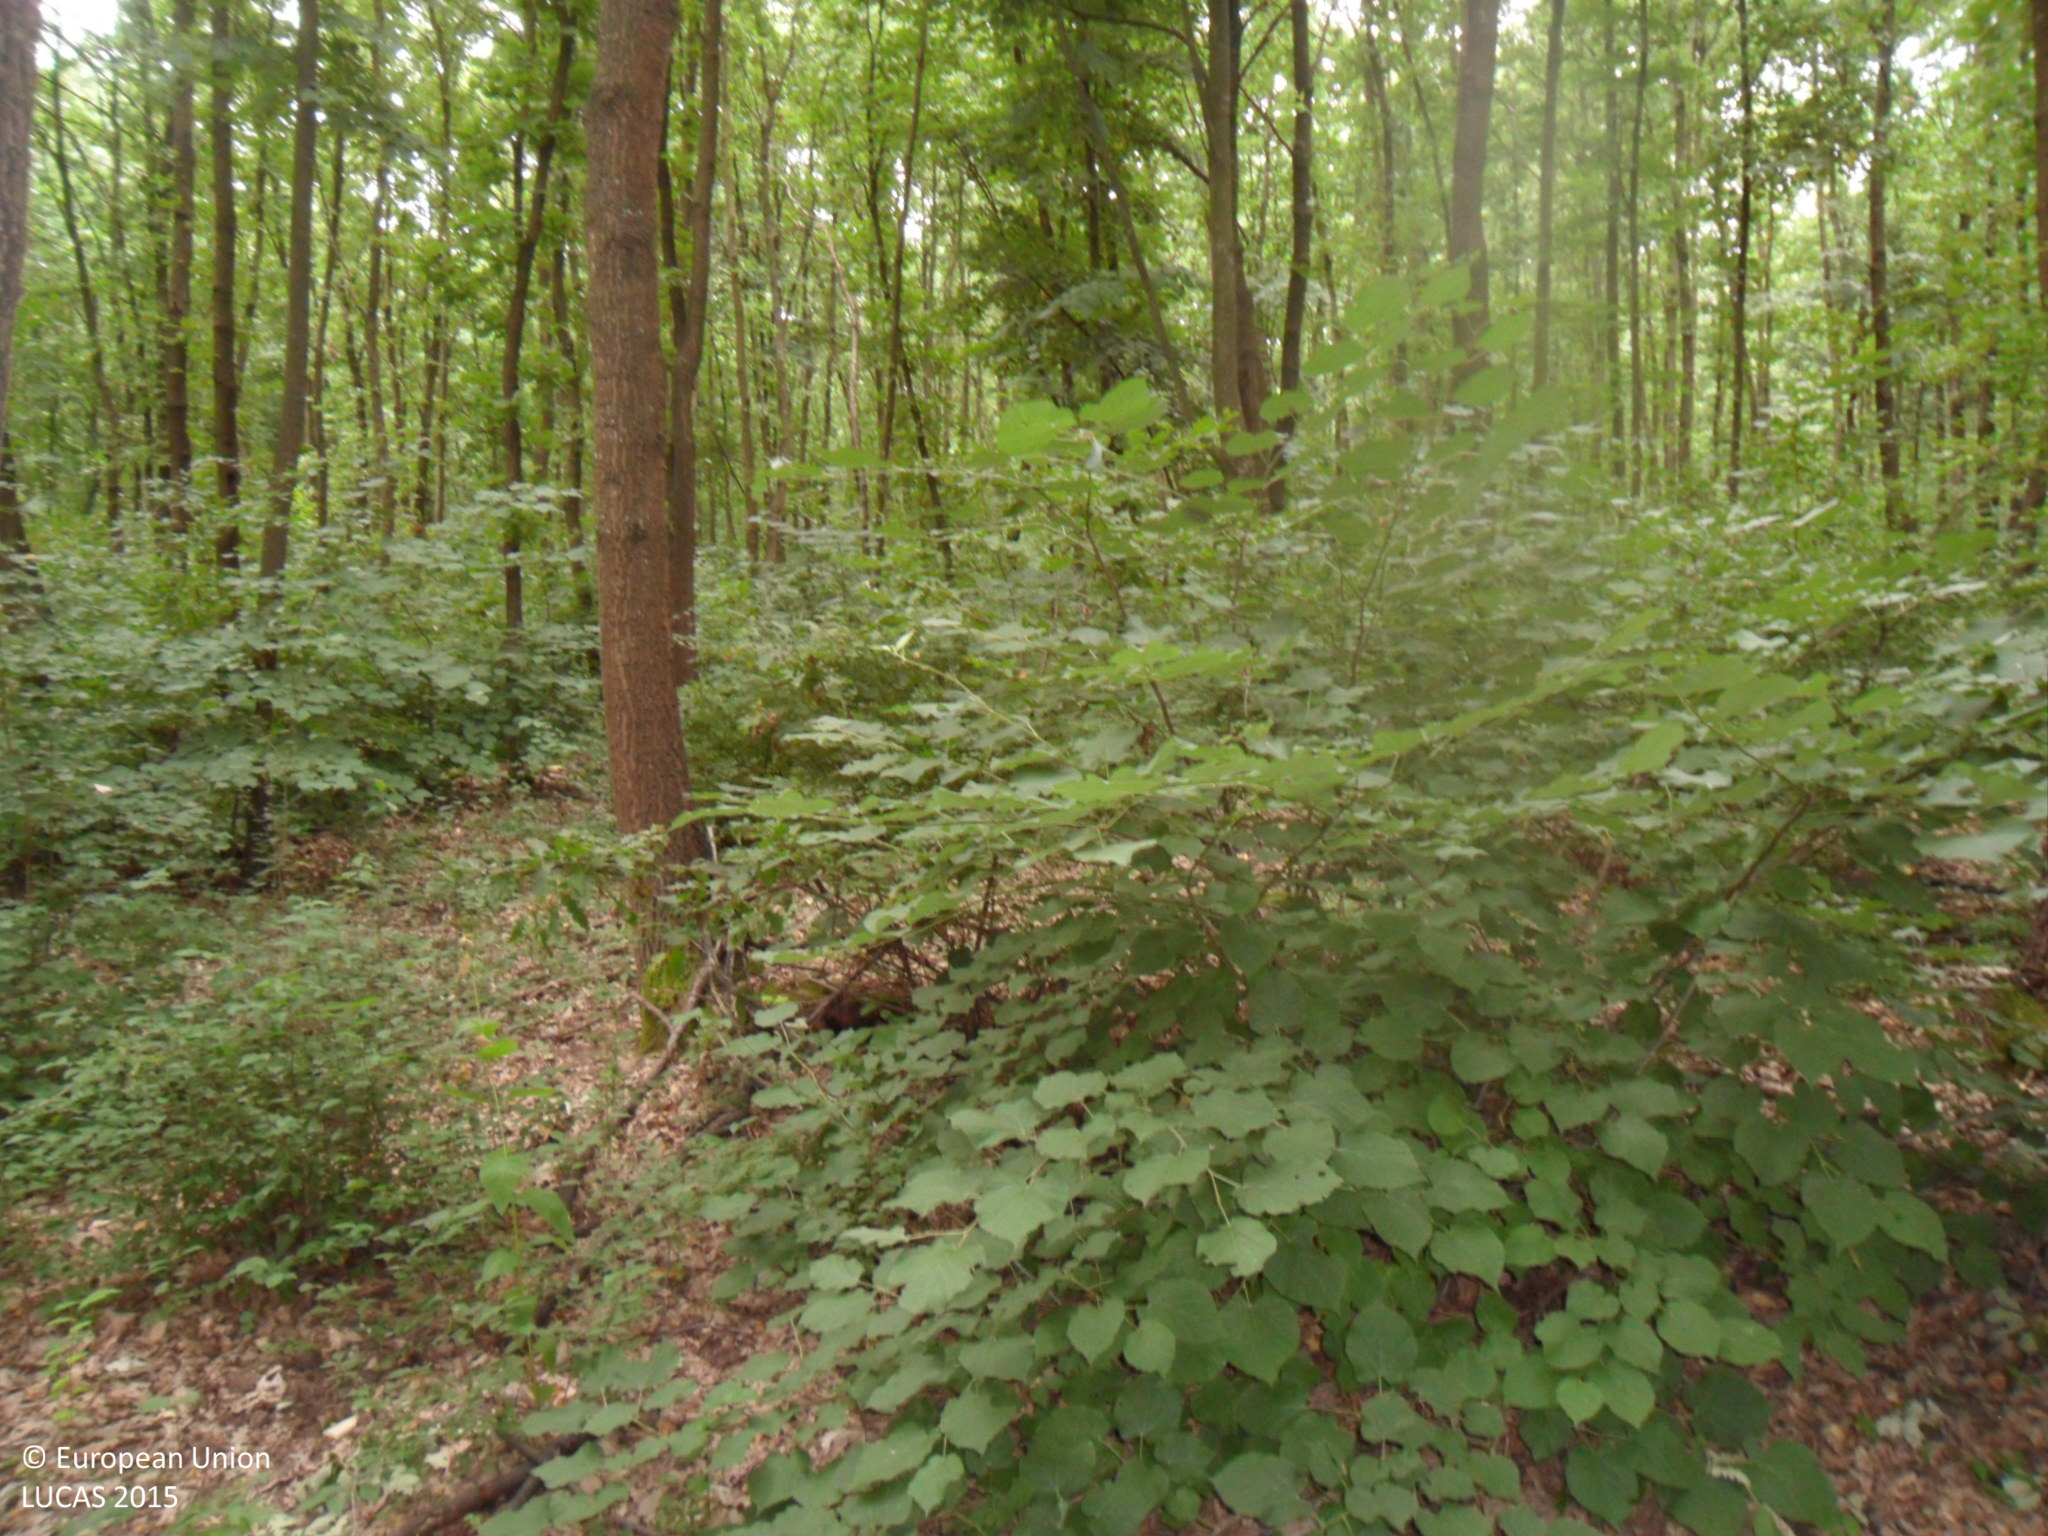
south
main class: Woodland
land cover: Broadleaved woodland
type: mesophytic deciduous forest
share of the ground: > 75 %
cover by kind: broadleaved forest trees 100 %
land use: Forestry
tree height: > 5 m
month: June
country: BG
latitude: 43.1335
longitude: 26.9157
